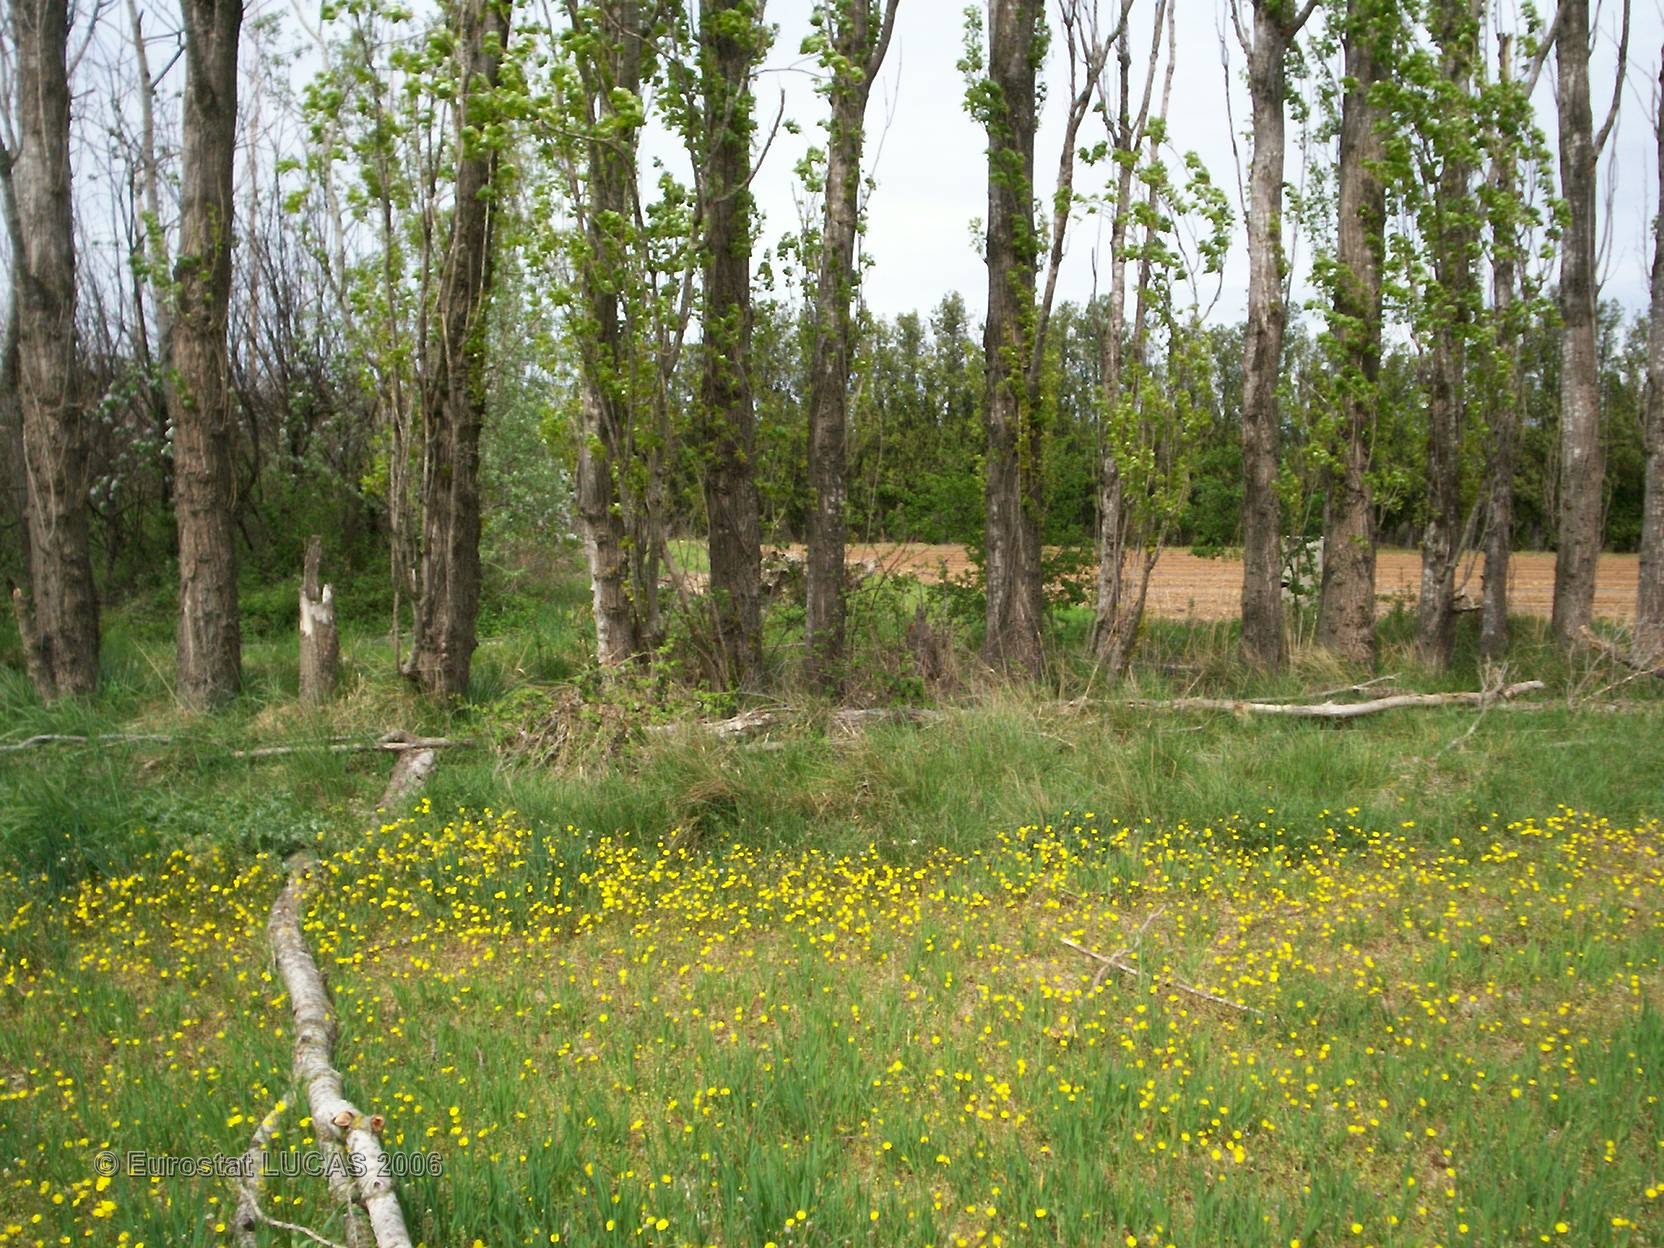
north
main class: Cropland
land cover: Oats
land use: Agriculture (excluding fallow land and kitchen gardens)
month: April
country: FR
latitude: 43.8132
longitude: 4.9741
